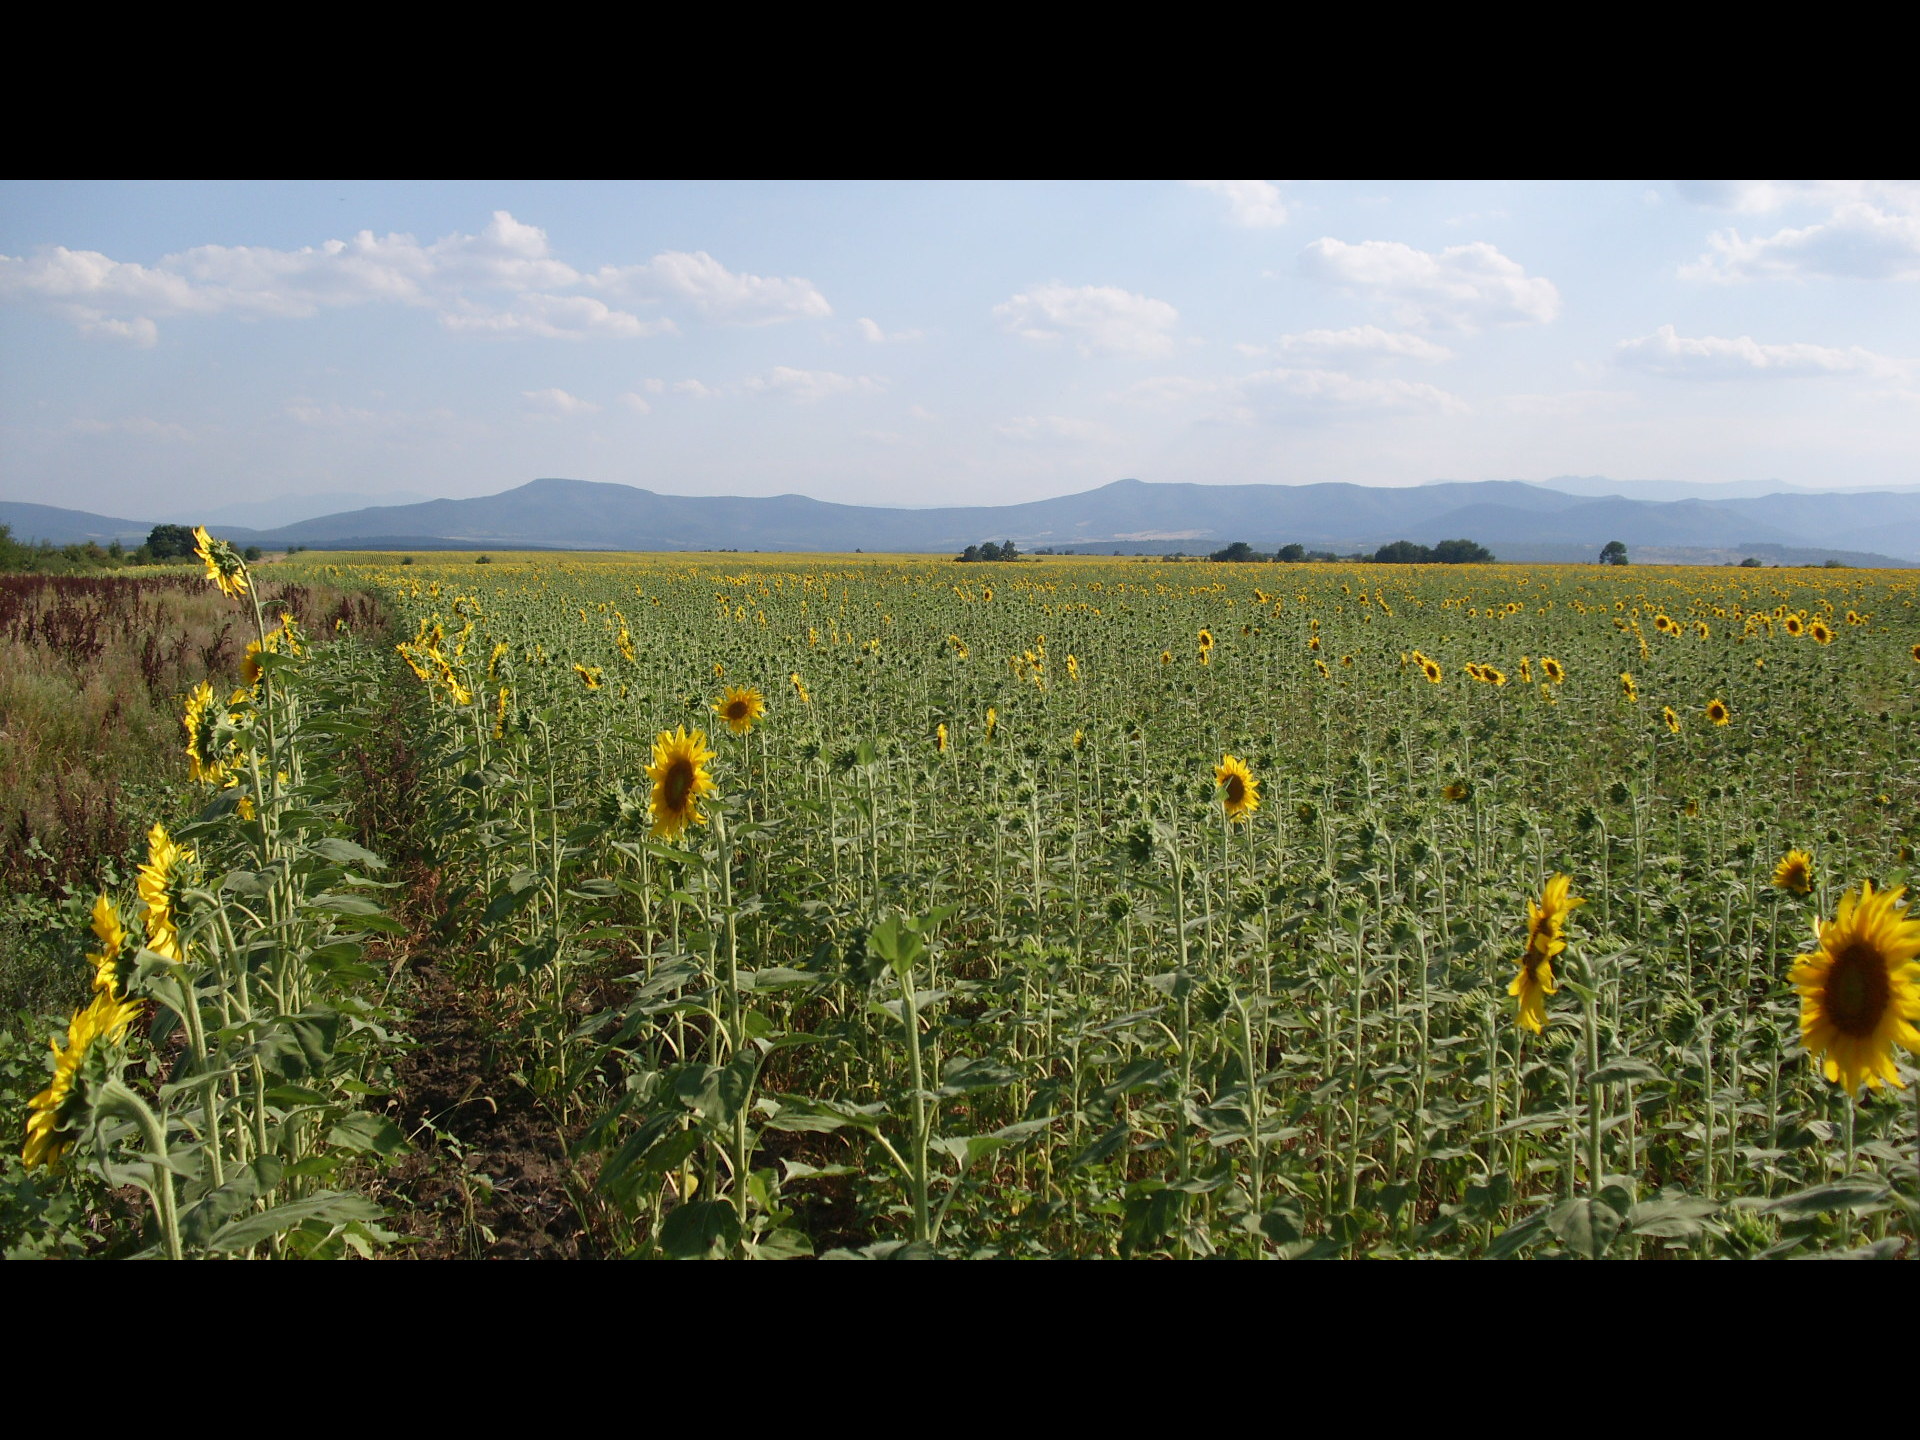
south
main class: Cropland
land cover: Sunflower
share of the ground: > 75 %
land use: Agriculture (excluding fallow land and kitchen gardens)
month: August
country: BG
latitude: 43.5799
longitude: 23.0289
